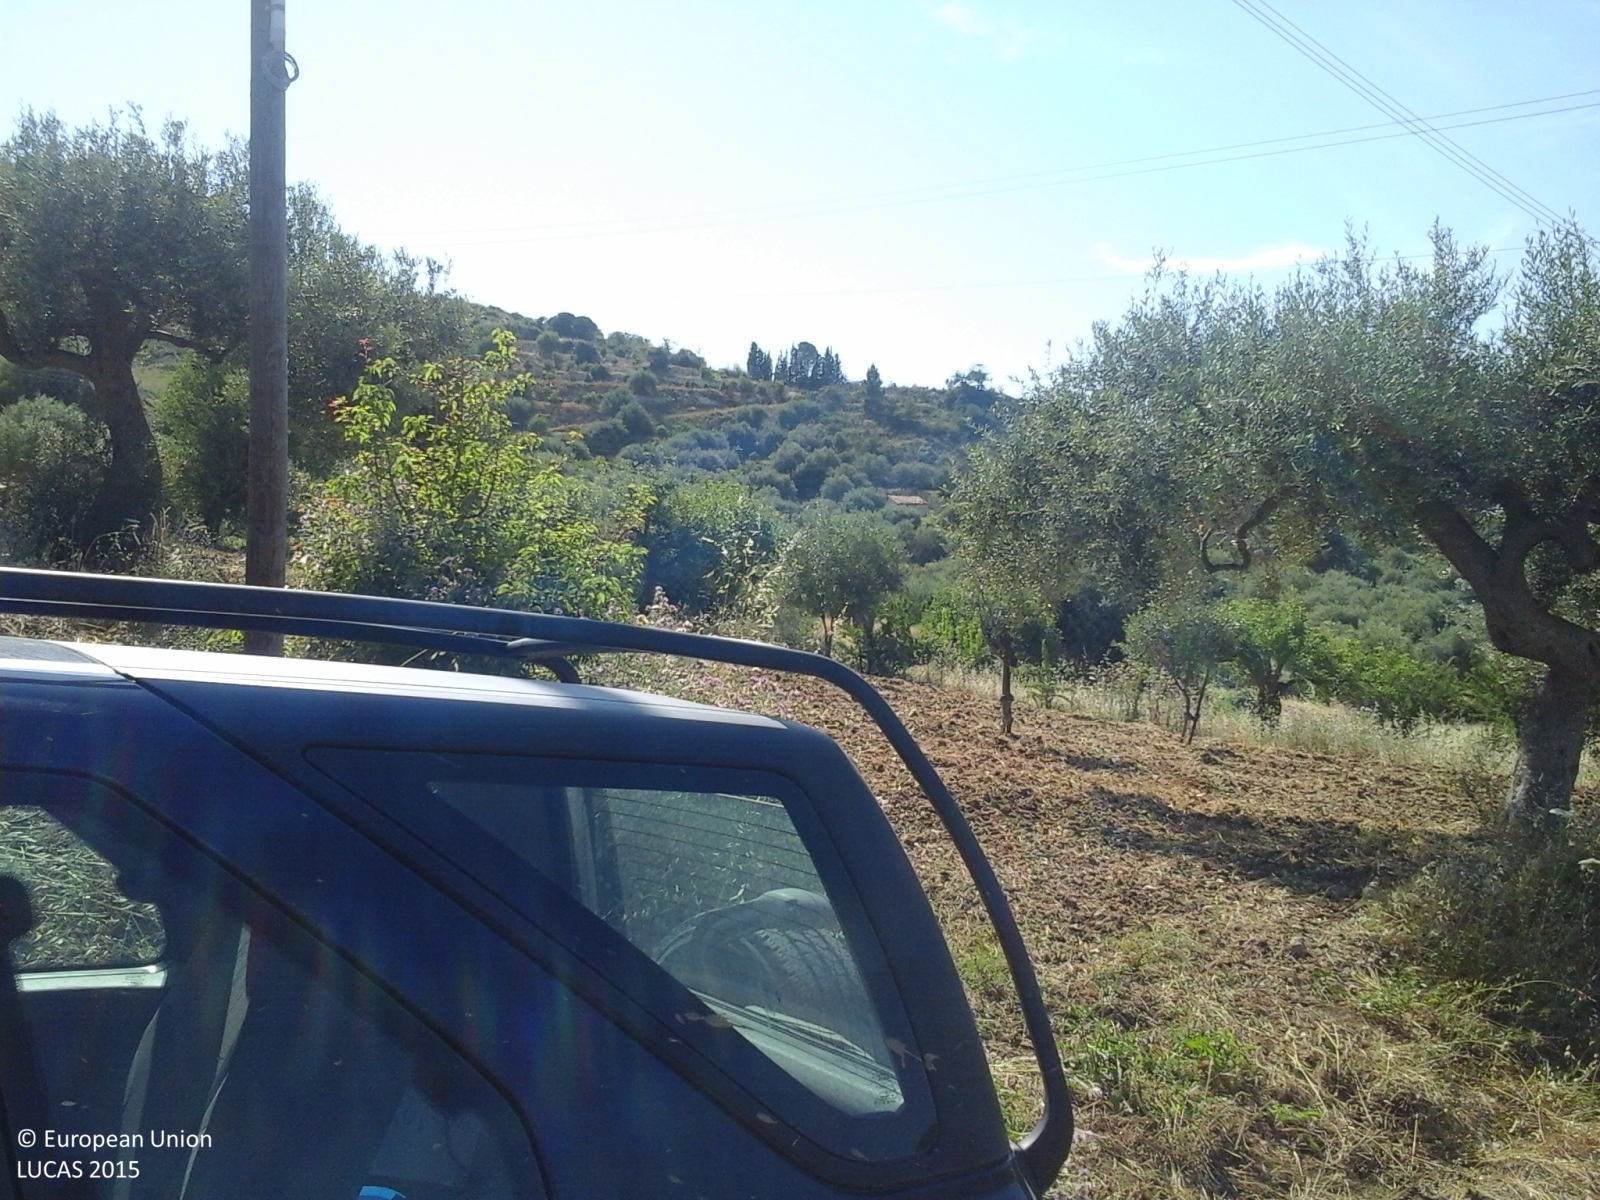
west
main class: Cropland
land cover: Olive groves
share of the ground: 50 - 75 %
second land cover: Spontaneously vegetated surfaces
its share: > 75 %
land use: Agriculture (excluding fallow land and kitchen gardens)
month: June
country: IT
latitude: 37.9927
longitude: 13.9465
